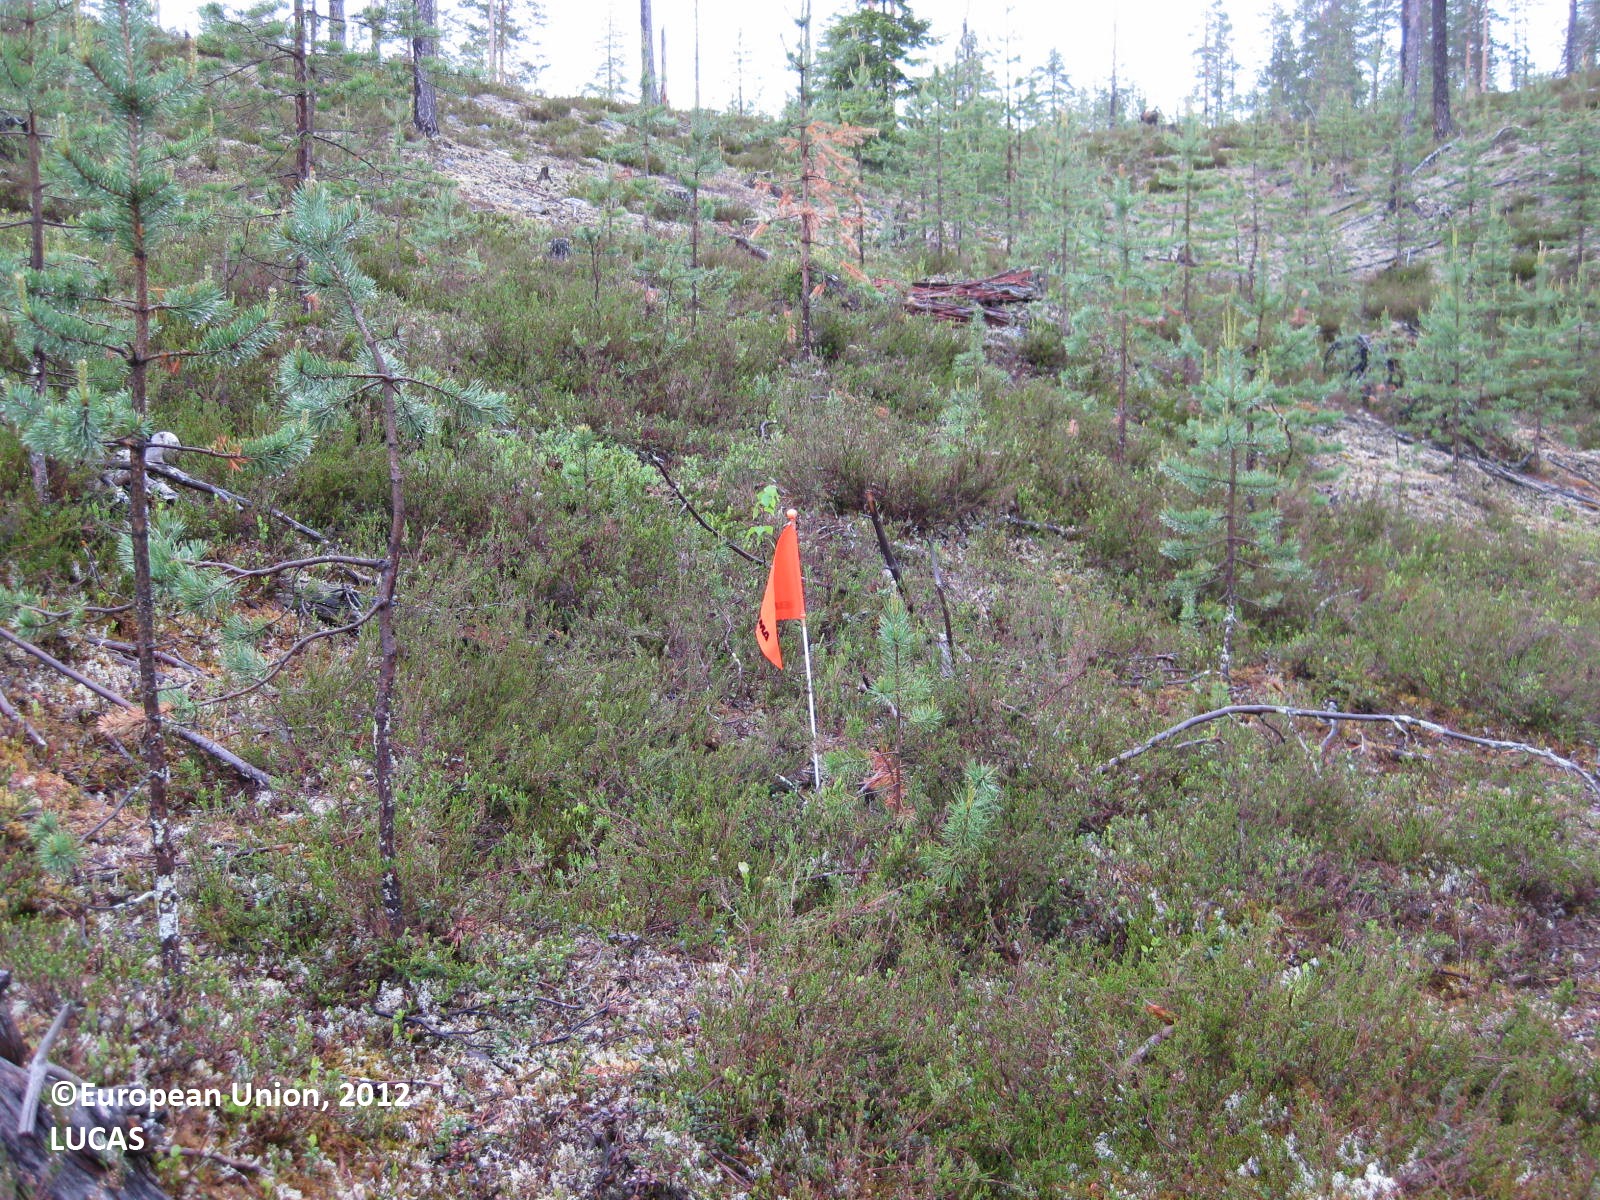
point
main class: Woodland
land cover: Pine dominated coniferous woodland
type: boreal forest
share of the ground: 50 - 75 %
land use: Forestry
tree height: > 5 m
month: June
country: FI
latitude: 65.4356
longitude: 29.6732
